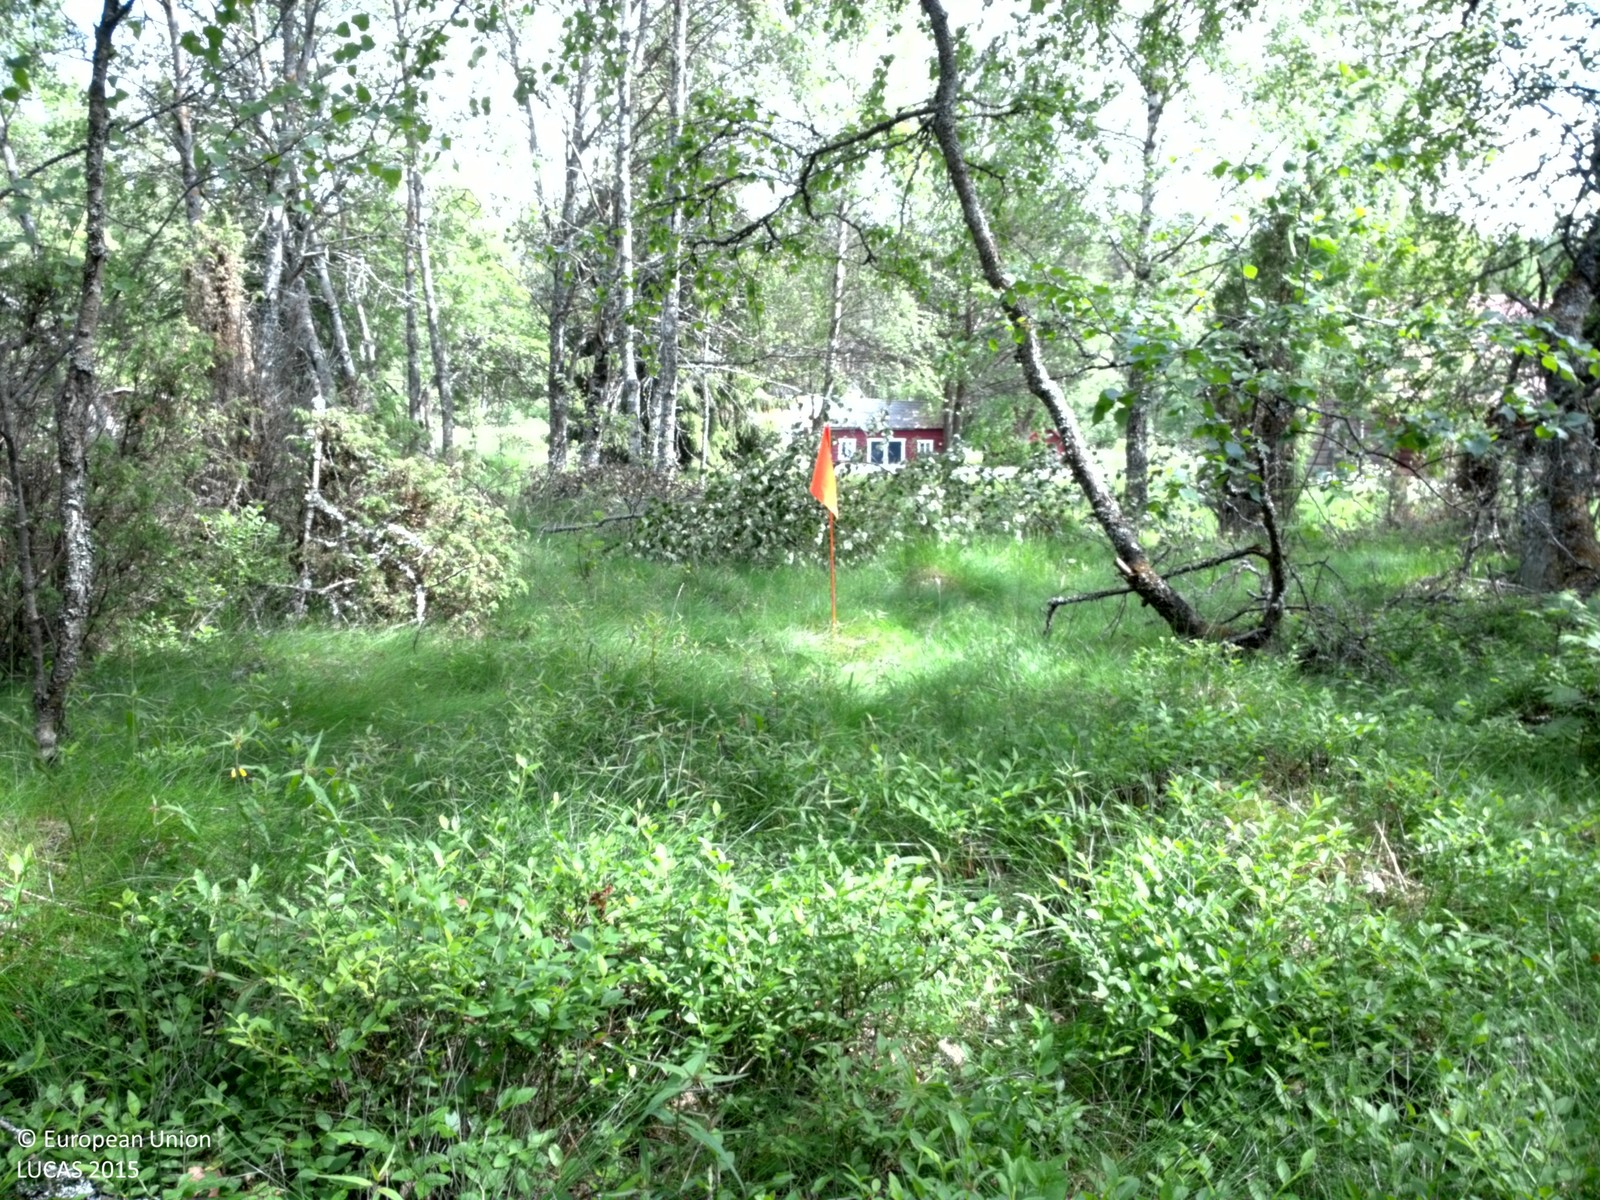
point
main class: Woodland
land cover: Broadleaved woodland
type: hemiboreal forest and nemoral coniferous forest and mixed broadleaved-coniferous forest
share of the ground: > 75 %
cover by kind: broadleaved forest trees 65 %, herbaceous plants 25 %, coniferous forest trees 10 %
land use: Forestry
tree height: > 5 m
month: June
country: SE
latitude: 59.9816
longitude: 17.1423
